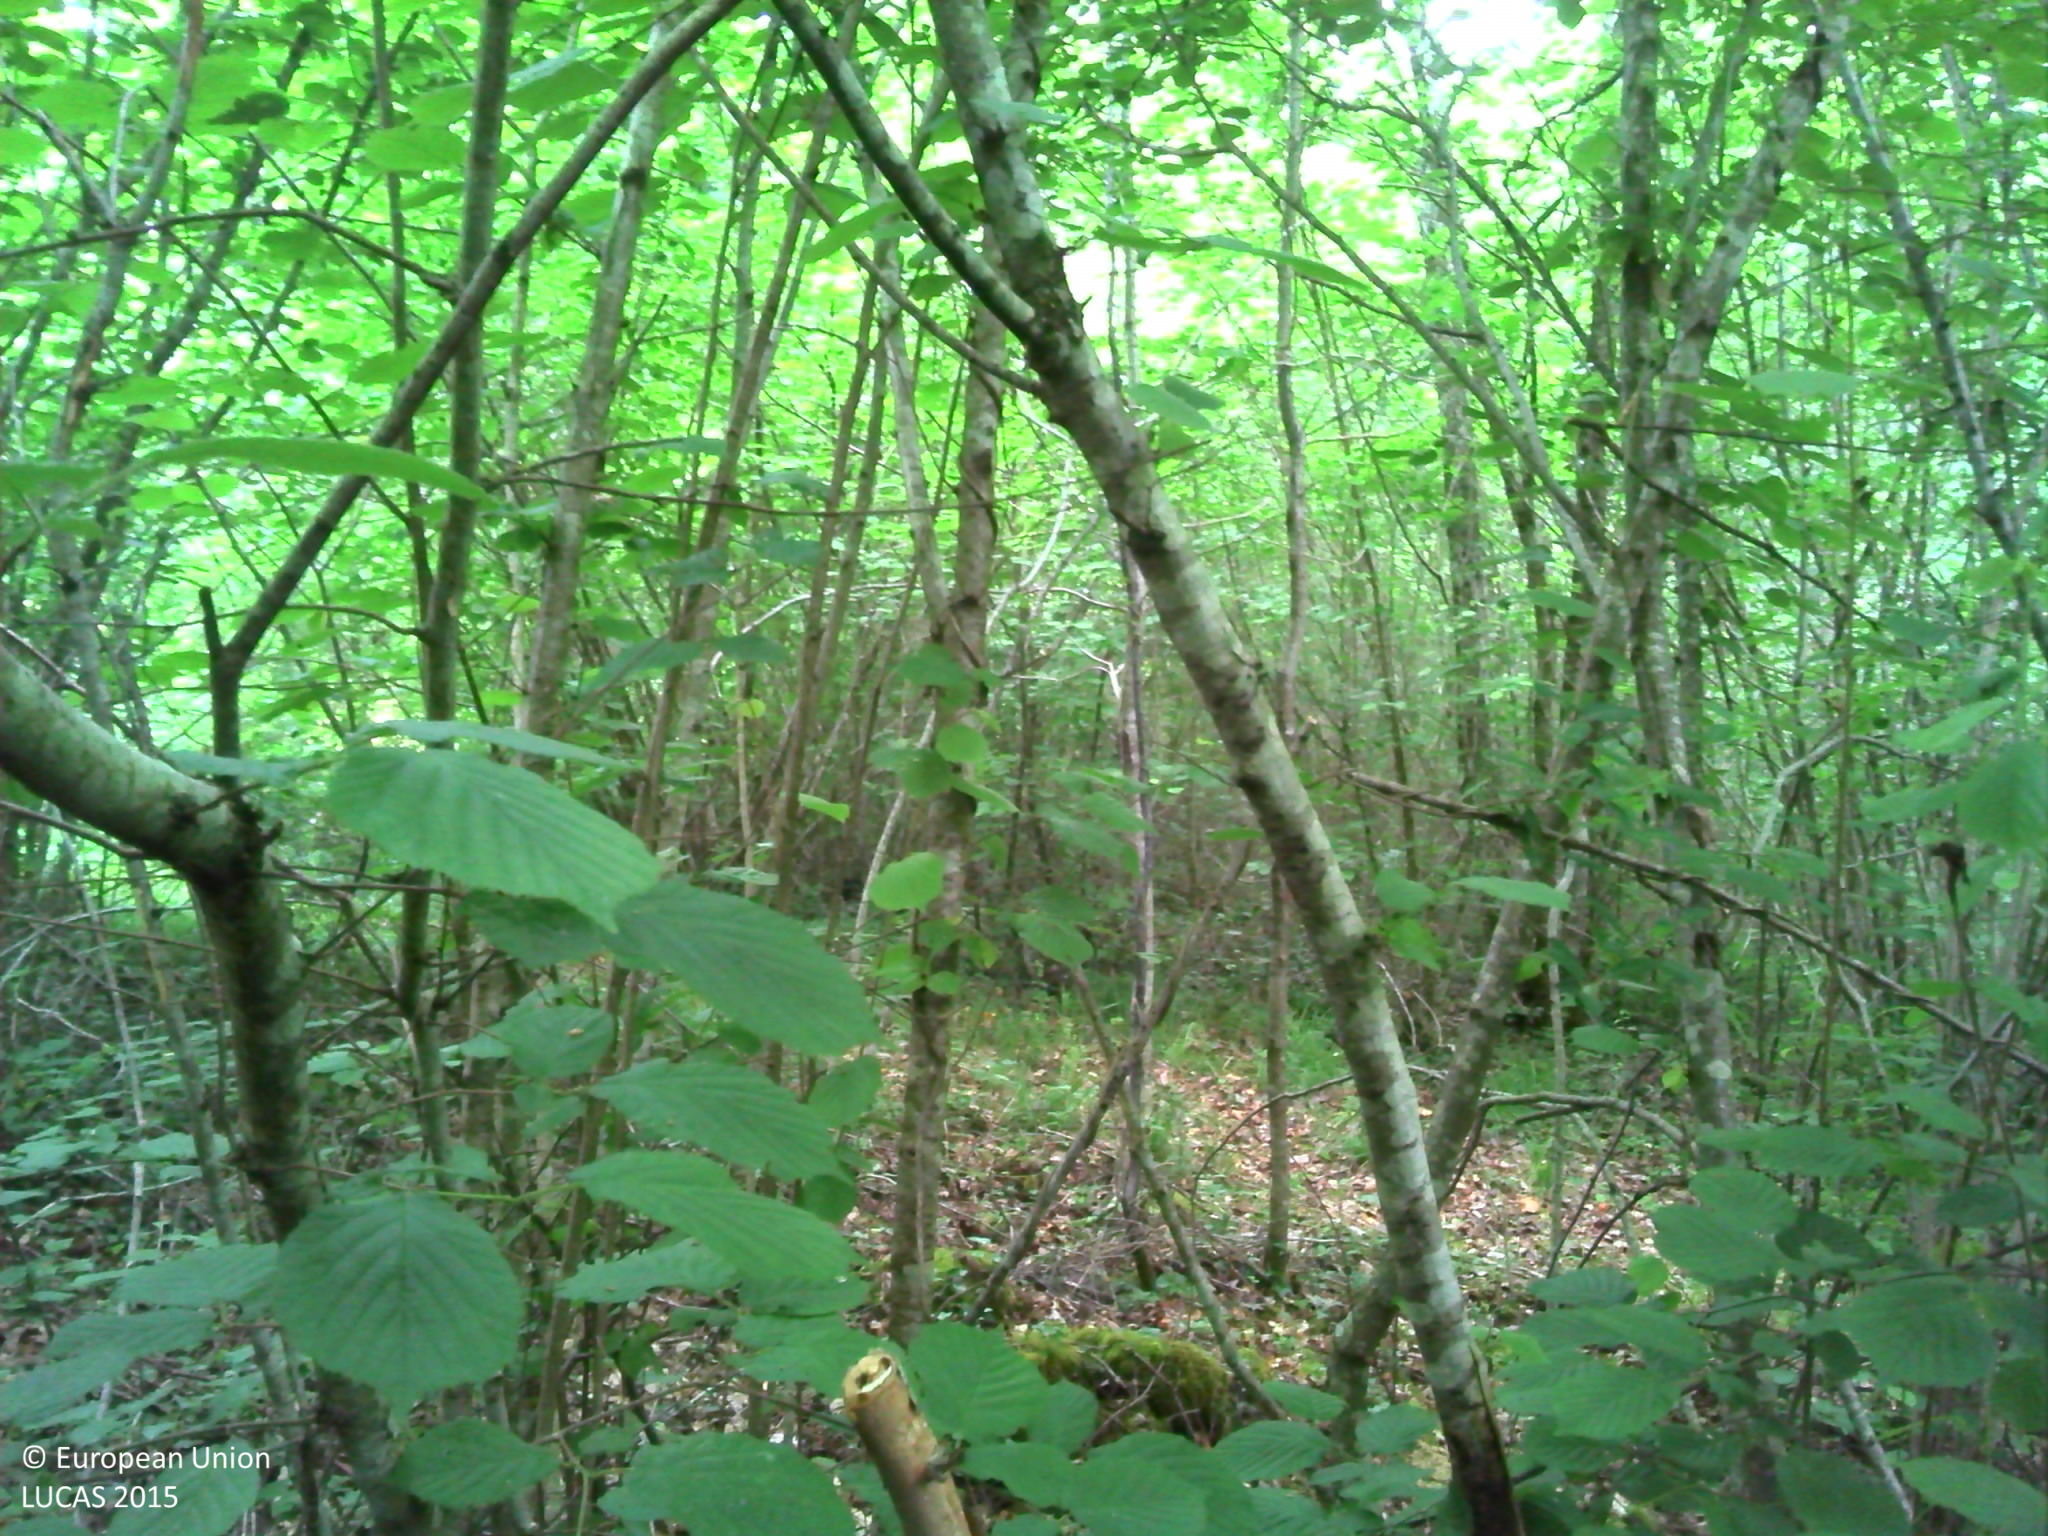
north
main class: Woodland
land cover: Broadleaved woodland
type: thermophilous deciduous forest
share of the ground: > 75 %
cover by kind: broadleaved forest trees 90 %, herbaceous plants 5 %, lichens and mosses 5 %
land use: Forestry
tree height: > 5 m
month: June
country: FR
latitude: 43.6049
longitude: 0.6945
